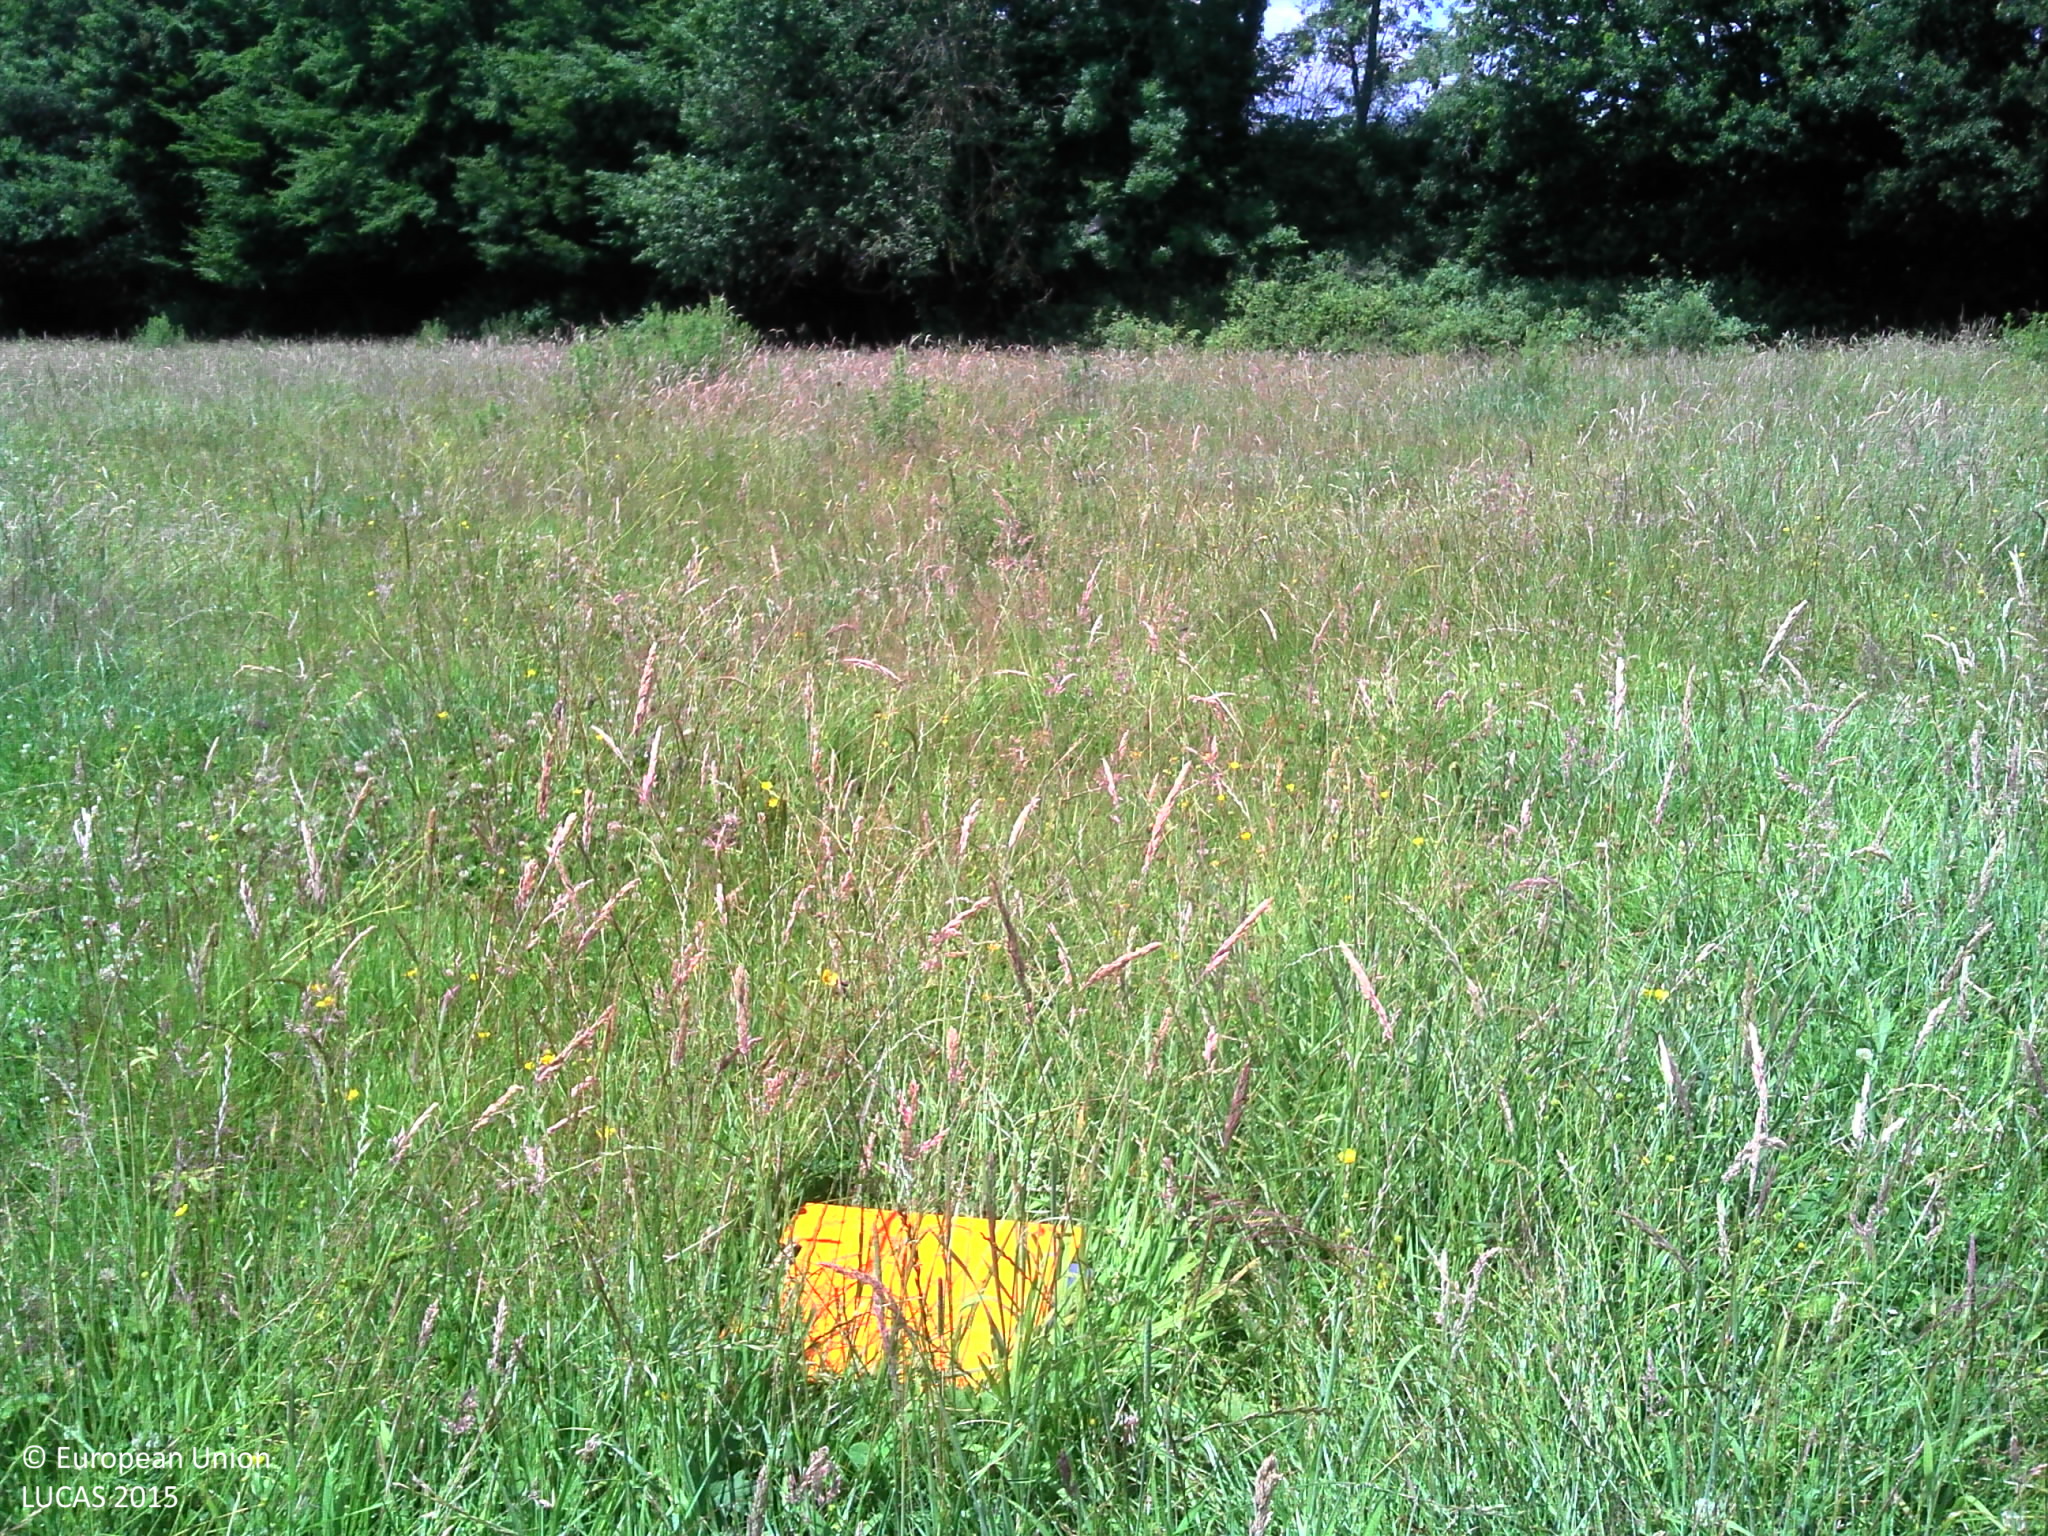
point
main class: Grassland
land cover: Grassland without tree/shrub cover
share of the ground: > 75 %
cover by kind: herbaceous plants 100 %
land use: Agriculture (excluding fallow land and kitchen gardens)
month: June
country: FR
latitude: 47.4008
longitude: 2.6656
